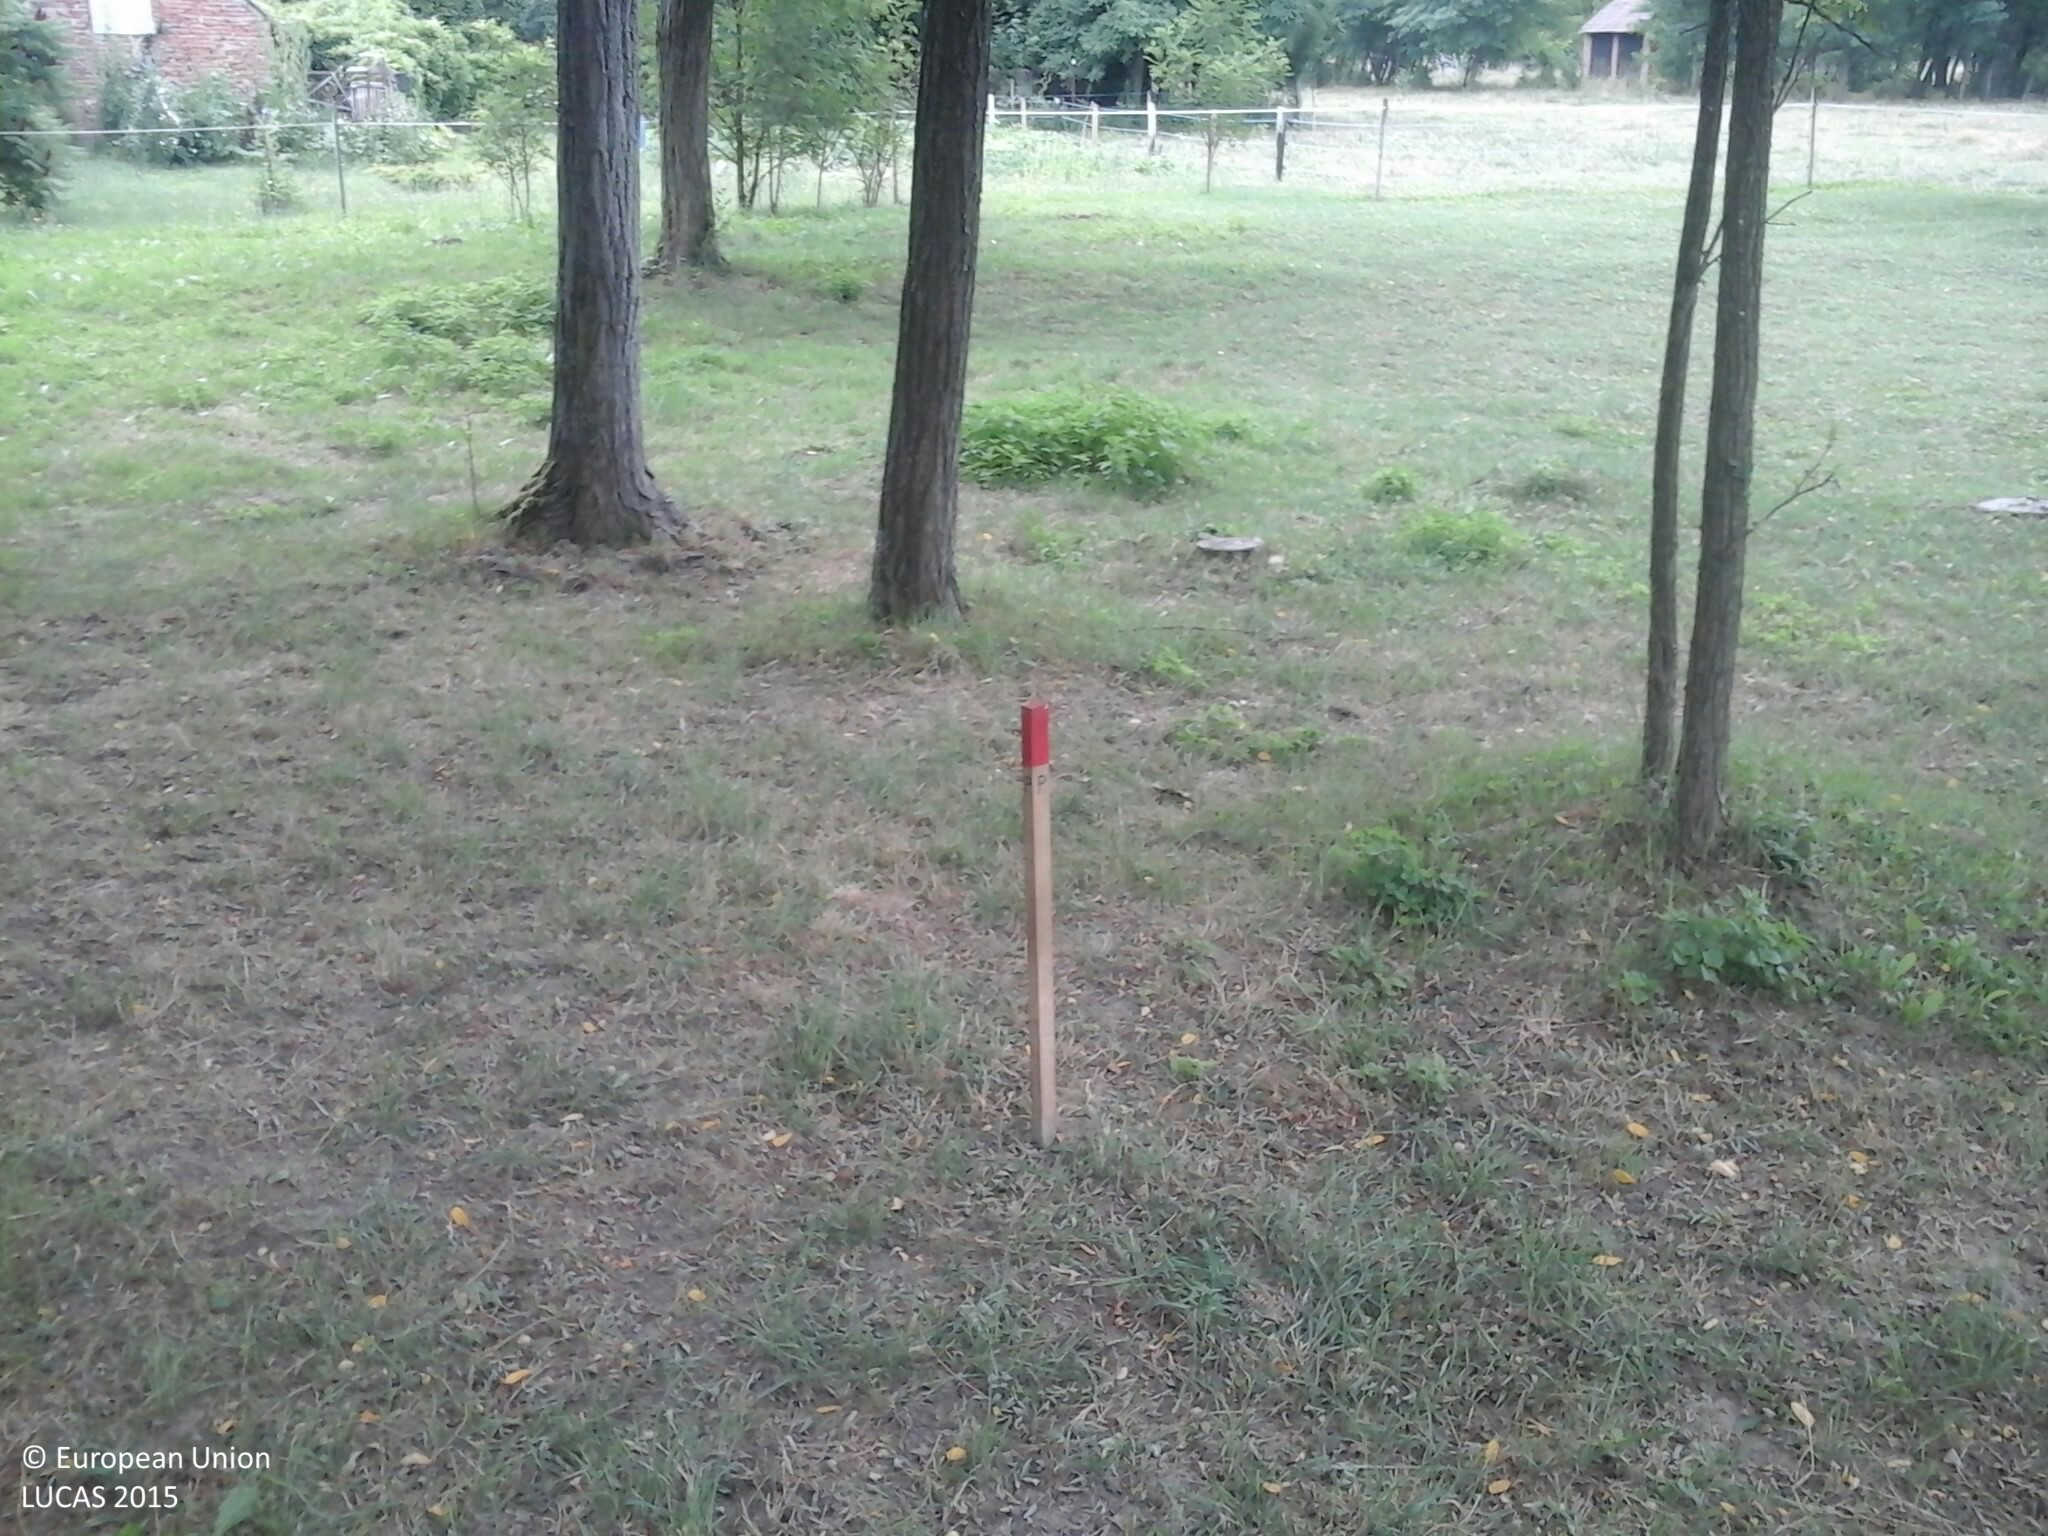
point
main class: Woodland
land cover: Broadleaved woodland
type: exotic forest
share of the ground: 50 - 75 %
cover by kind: herbaceous plants 60 %, broadleaved forest trees 40 %
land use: Residential
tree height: > 5 m
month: July
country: HU
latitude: 47.0702
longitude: 16.5740
